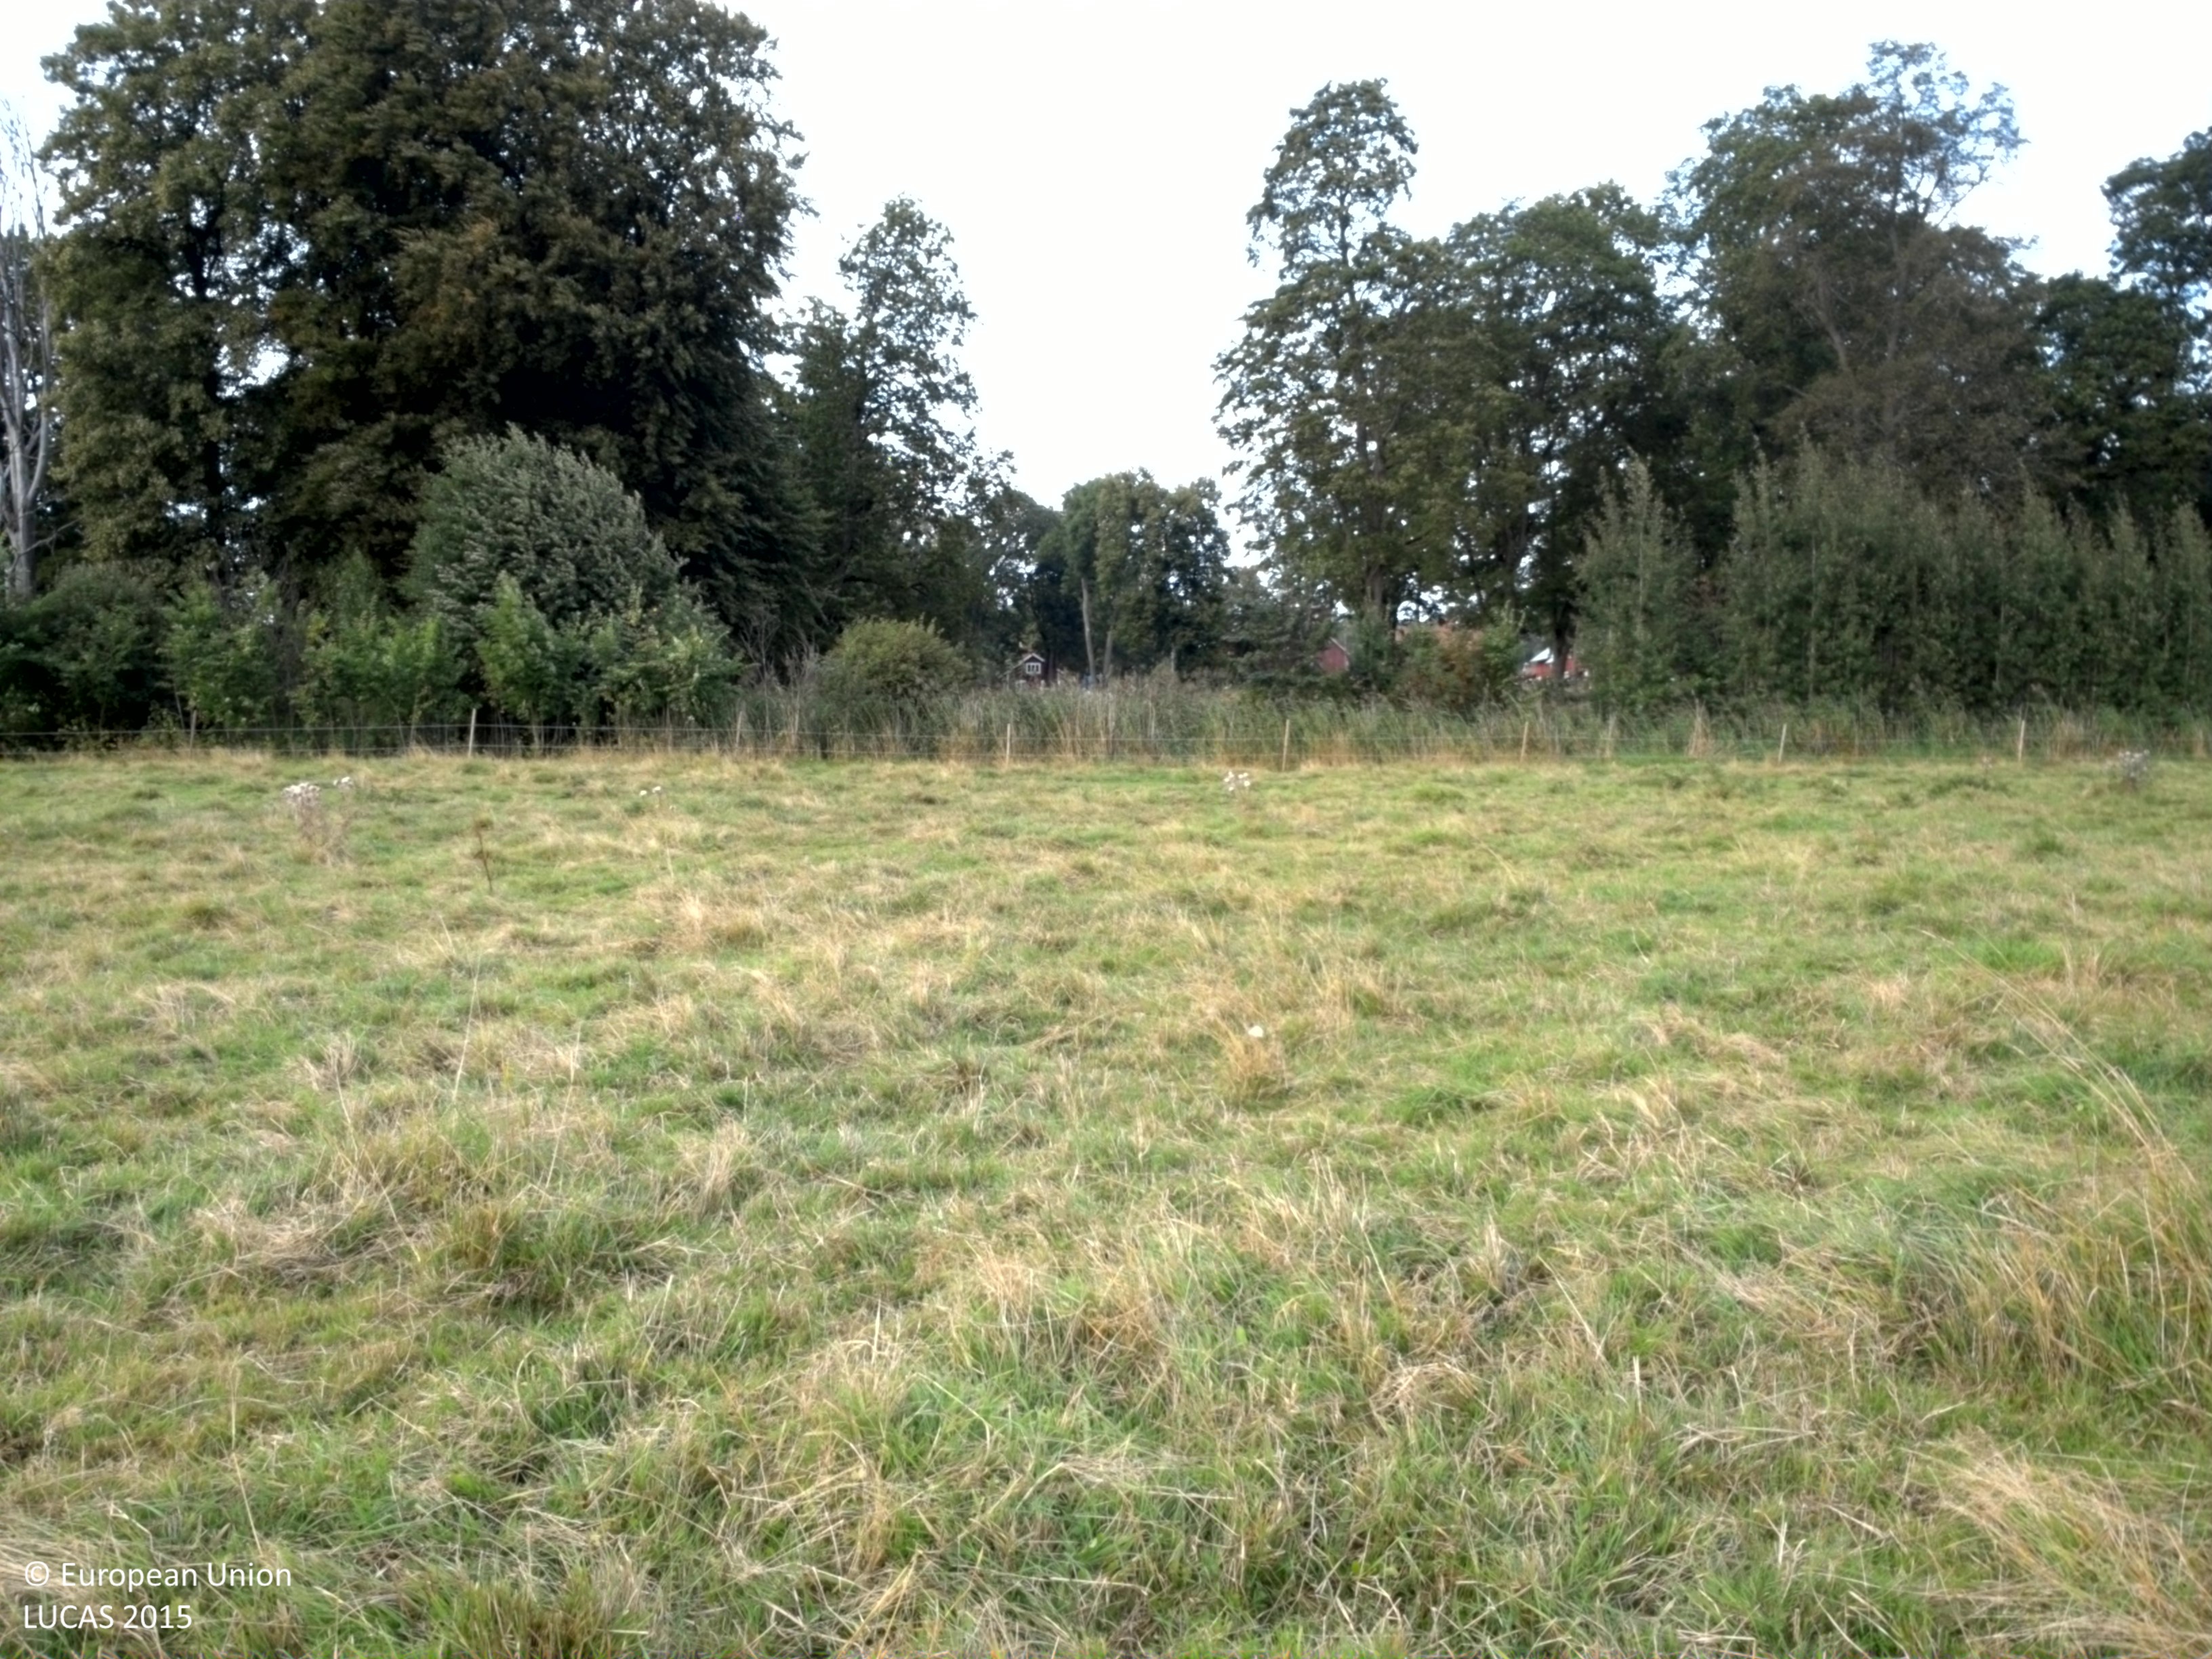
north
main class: Grassland
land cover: Grassland without tree/shrub cover
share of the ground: > 75 %
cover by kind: herbaceous plants 100 %
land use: Agriculture (excluding fallow land and kitchen gardens)
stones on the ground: < 10 %
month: August
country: SE
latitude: 60.0129
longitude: 17.5809
